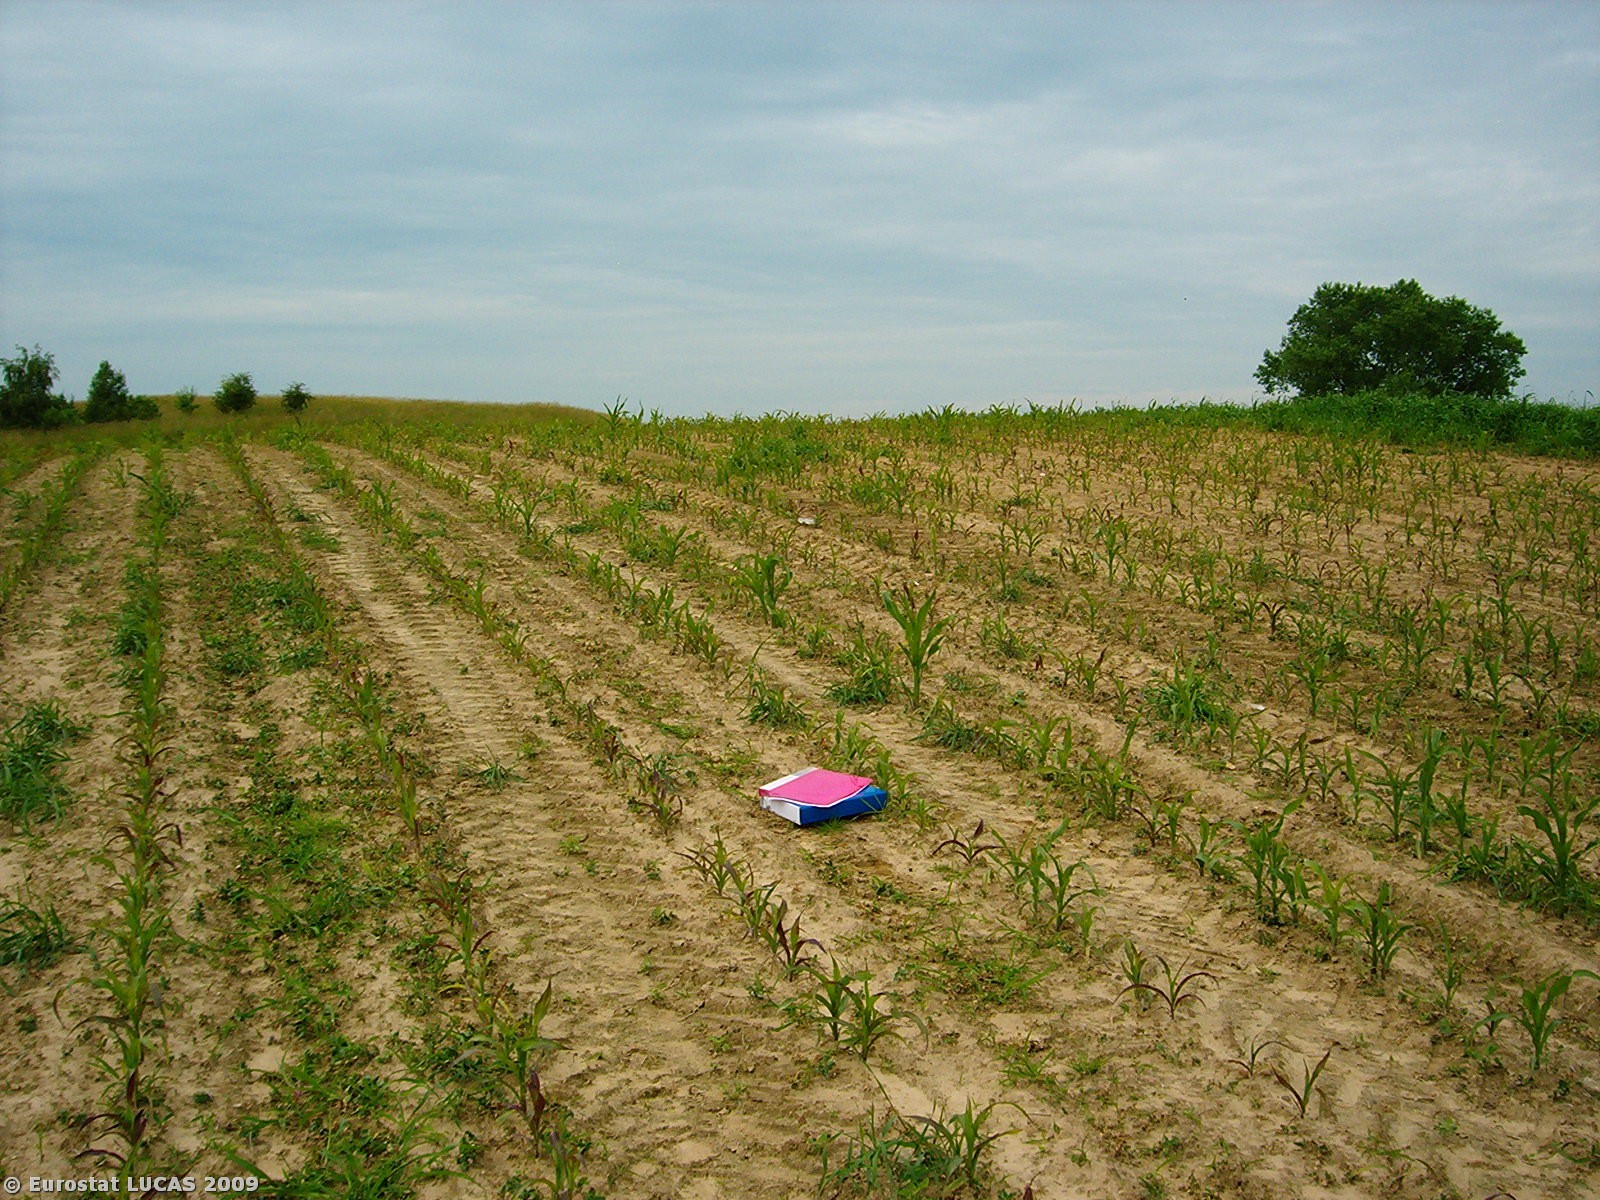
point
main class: Cropland
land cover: Maize
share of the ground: 10 - 25 %
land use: Agriculture (excluding fallow land and kitchen gardens)
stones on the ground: < 10 %
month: June
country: PL
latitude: 53.0989
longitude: 15.4547
